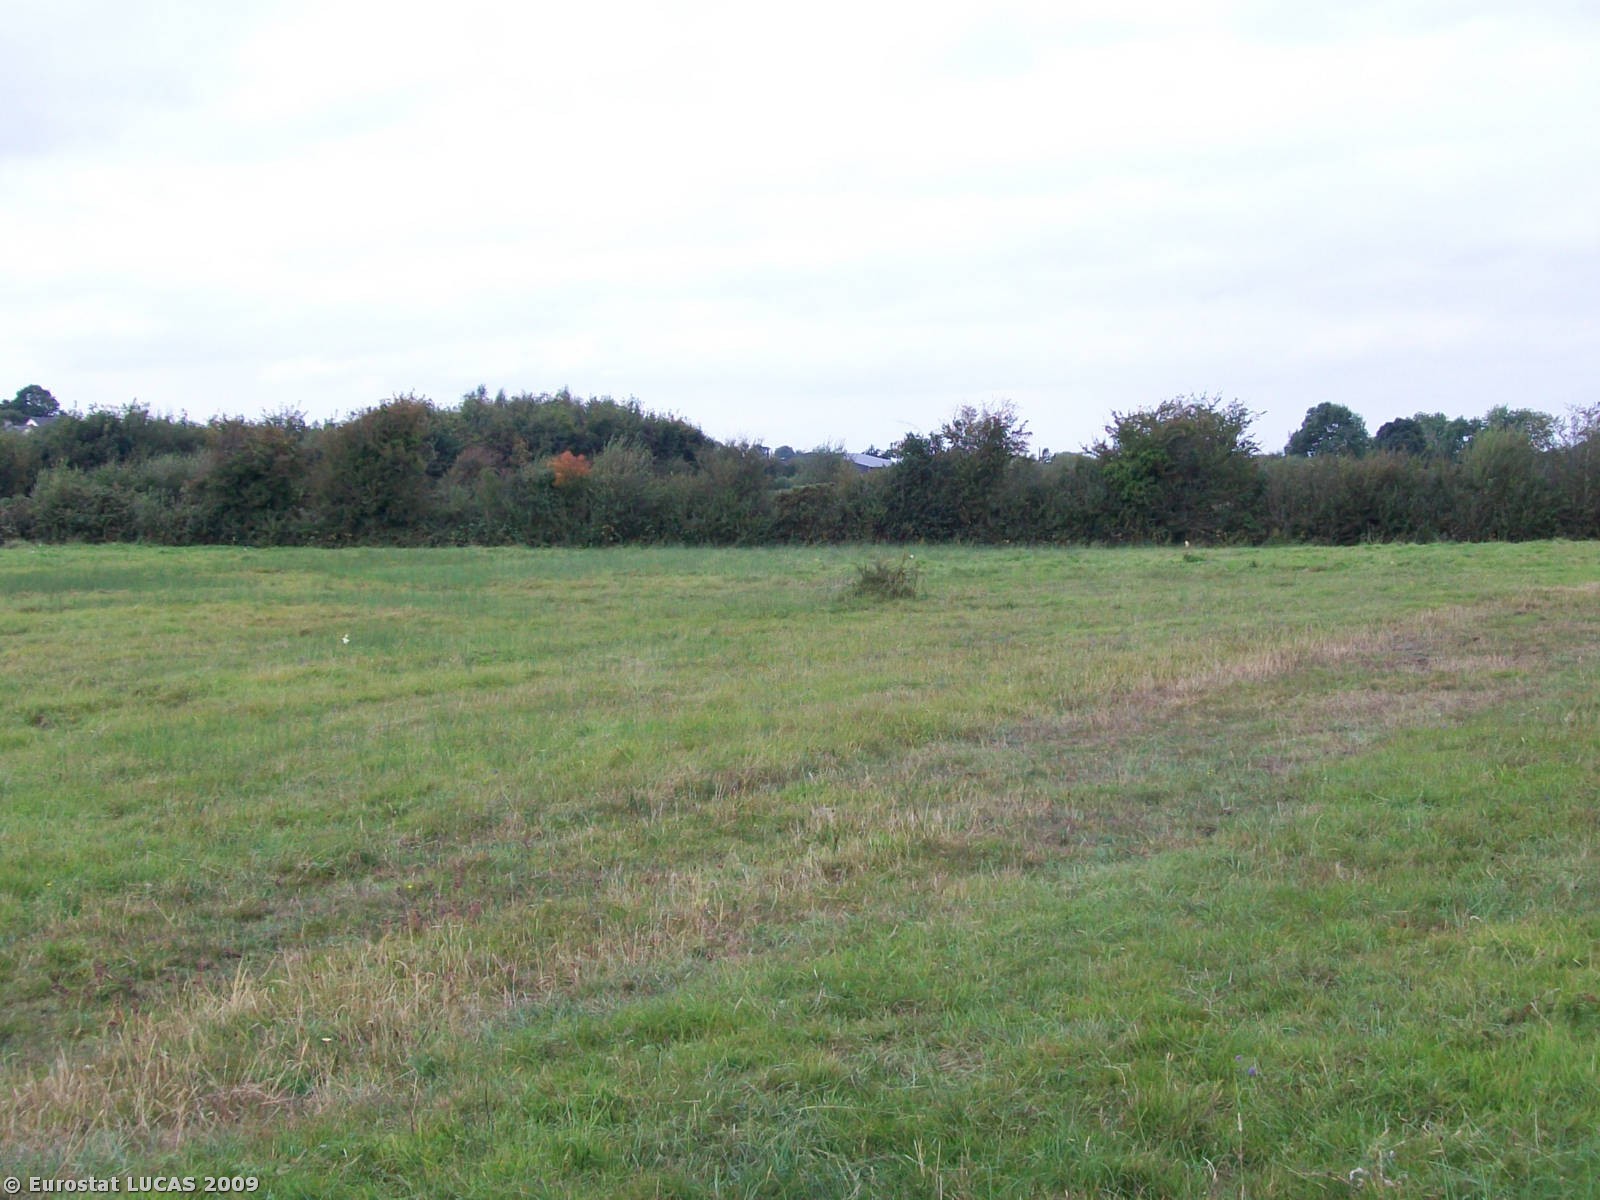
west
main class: Grassland
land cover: Grassland without tree/shrub cover
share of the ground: > 75 %
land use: Agriculture (excluding fallow land and kitchen gardens)
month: September
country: IE
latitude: 52.9599
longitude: -7.8717
